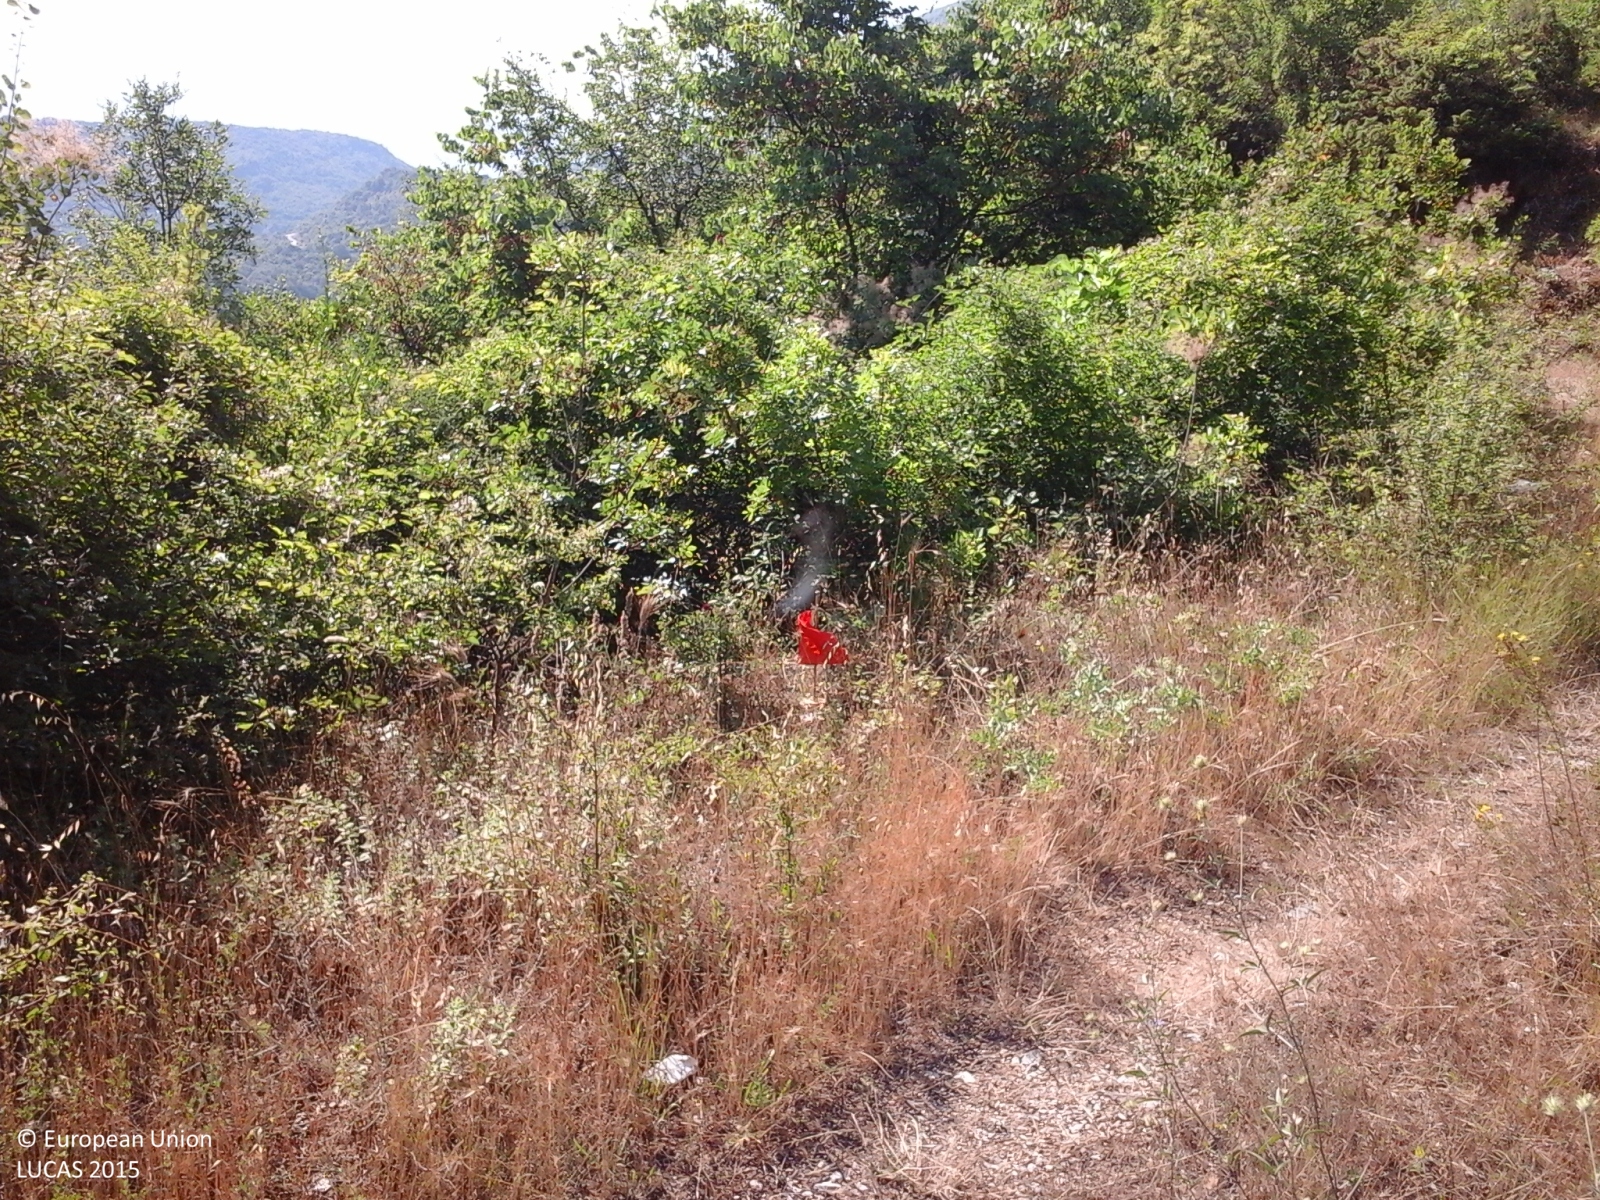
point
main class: Shrubland
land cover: Shrubland with sparse tree cover
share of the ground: > 75 %
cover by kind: shrubs 85 %, herbaceous plants 10 %, broadleaved forest trees 5 %
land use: Semi-natural and natural areas not in use
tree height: < 5 m
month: July
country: GR
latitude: 40.0597
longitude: 20.5672
